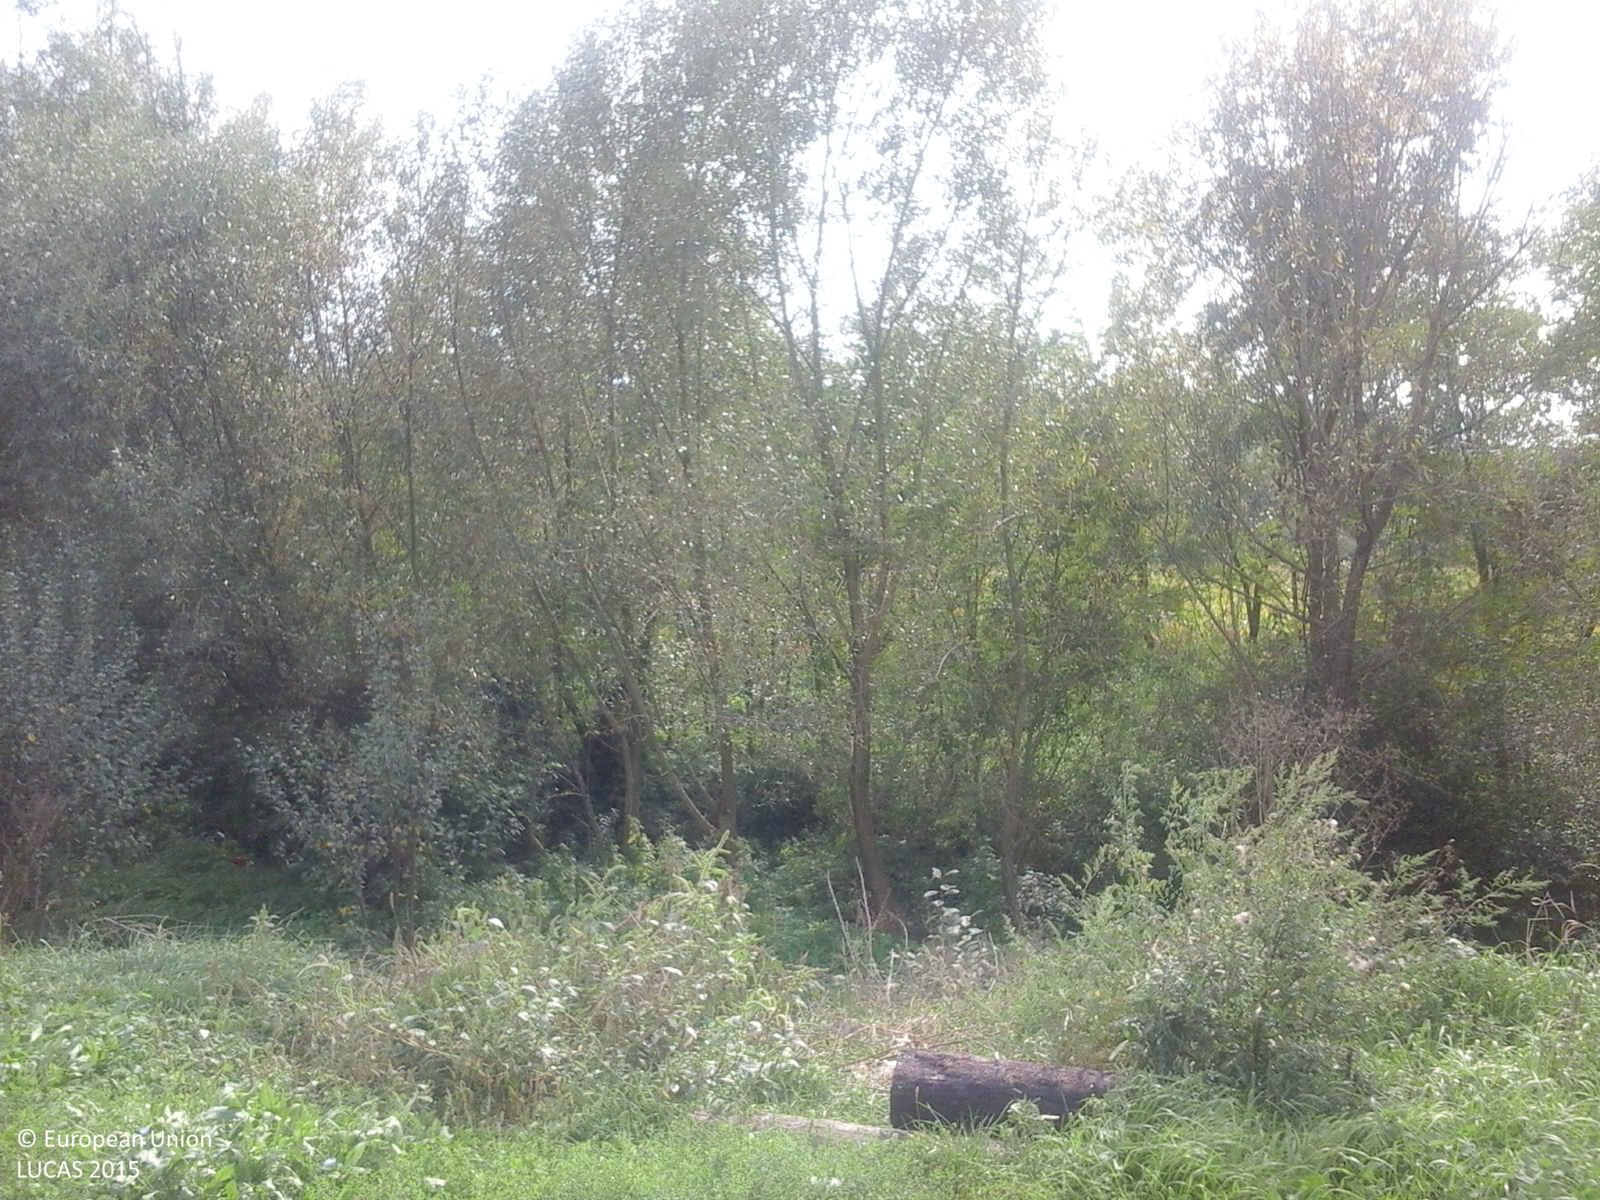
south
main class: Grassland
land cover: Spontaneously vegetated surfaces
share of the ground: > 75 %
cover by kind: herbaceous plants 100 %
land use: Fallow land
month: September
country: RO
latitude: 46.9294
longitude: 23.6670
